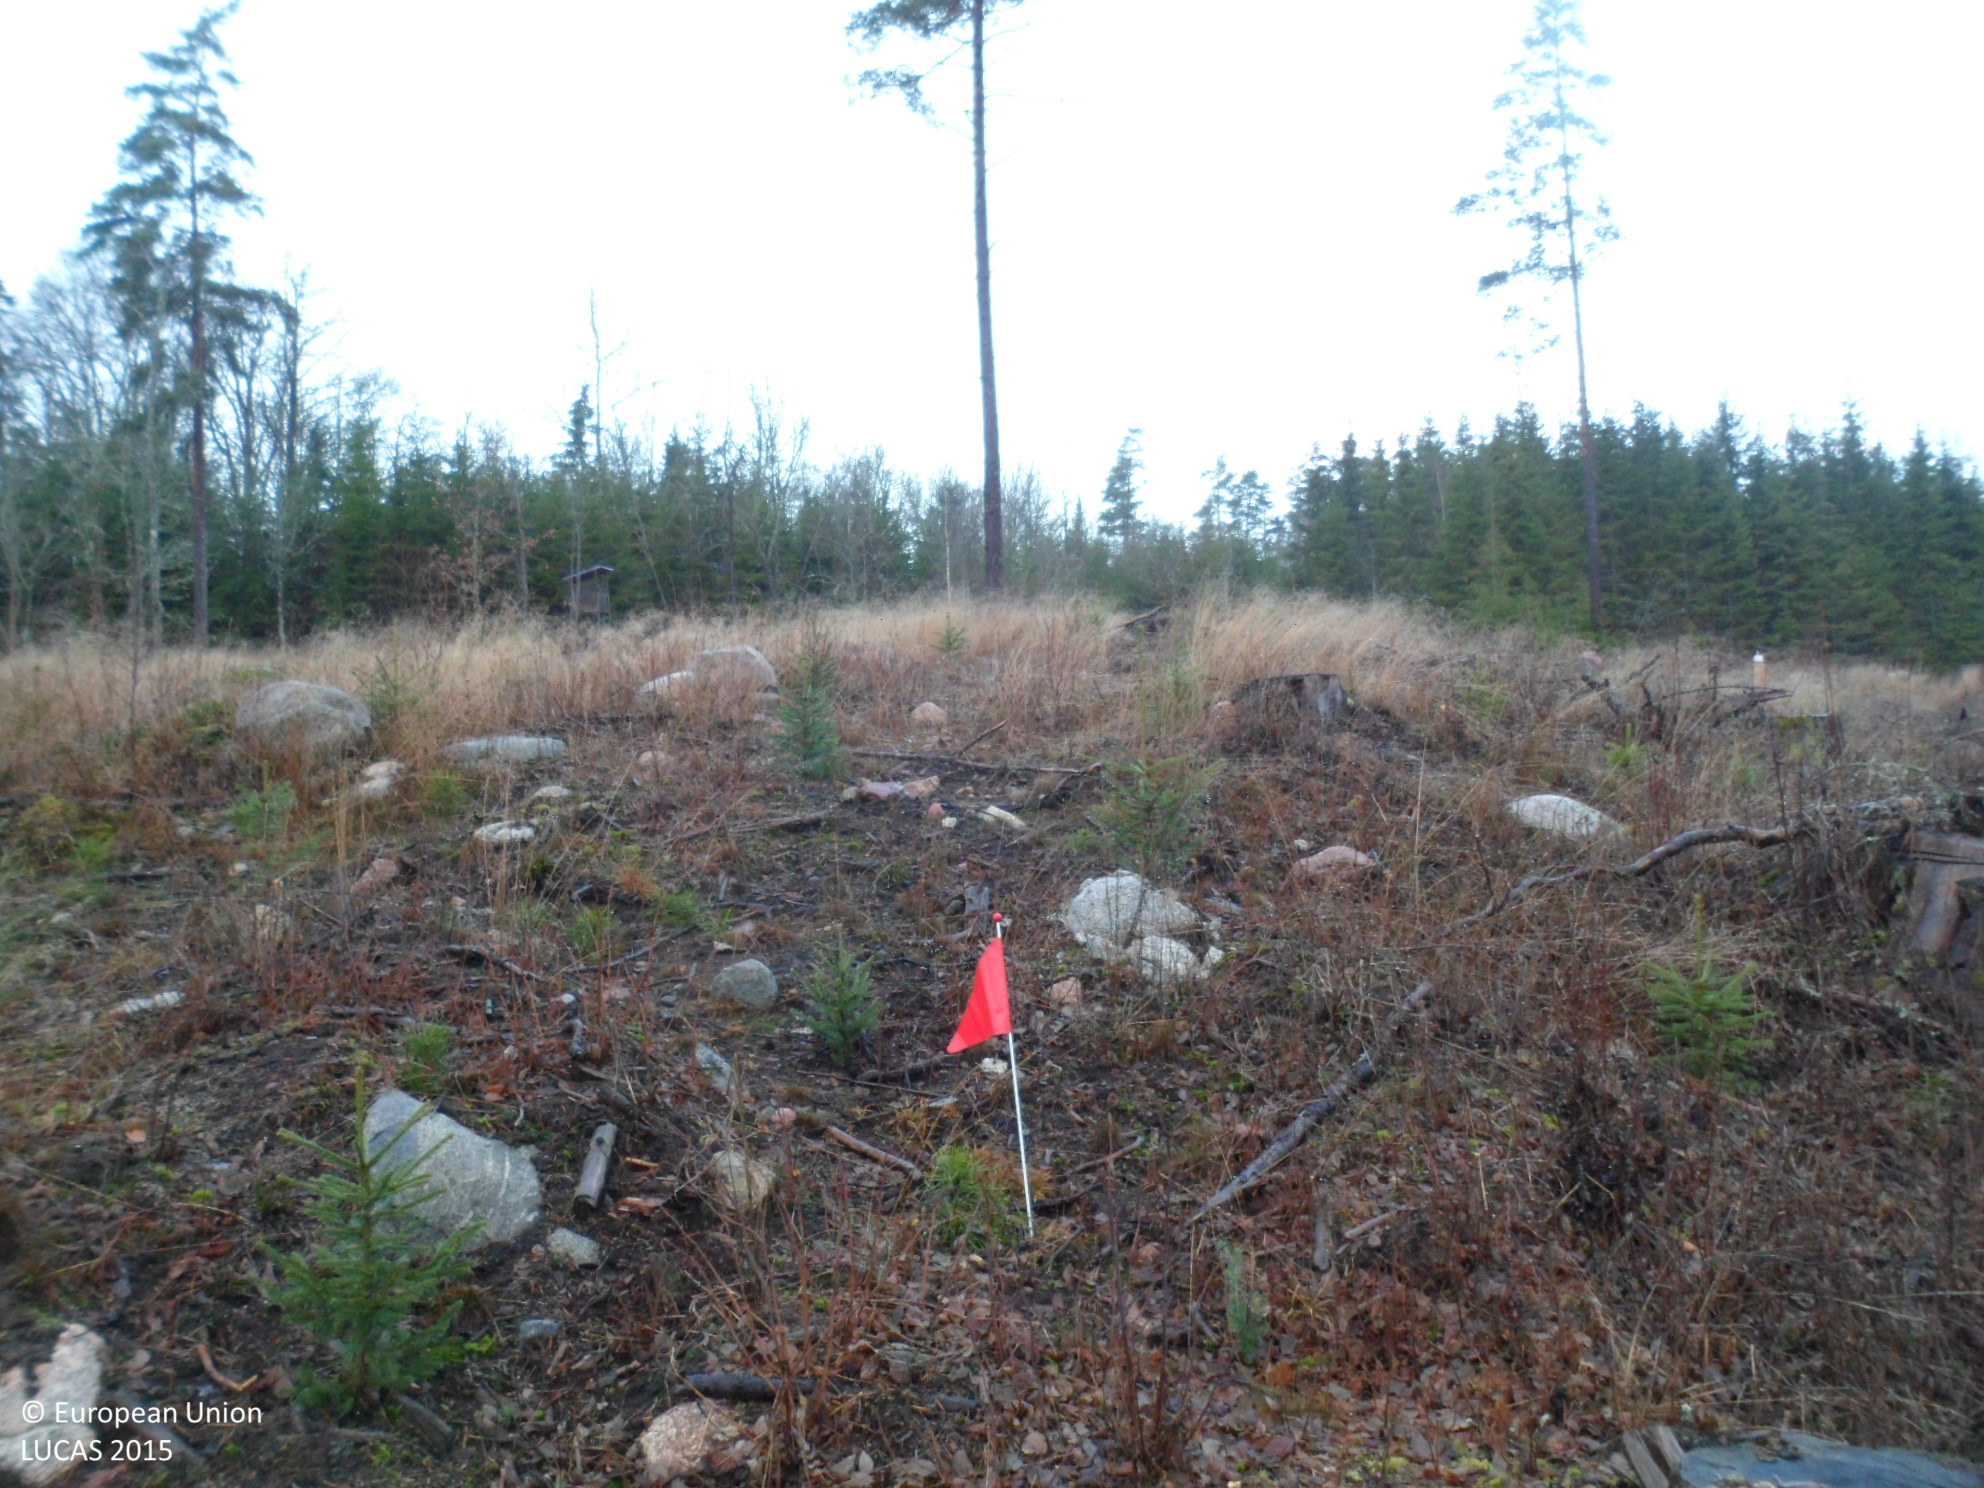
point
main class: Woodland
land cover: Spruce dominated mixed woodland
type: boreal forest
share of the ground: < 10 %
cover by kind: herbaceous plants 40 %, lichens and mosses 30 %, shrubs 10 %, unconsolidated bare surface 10 %, coniferous forest trees 5 %, broadleaved forest trees 5 %
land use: Forestry
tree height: < 5 m
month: November
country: SE
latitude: 57.4887
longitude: 15.1845
